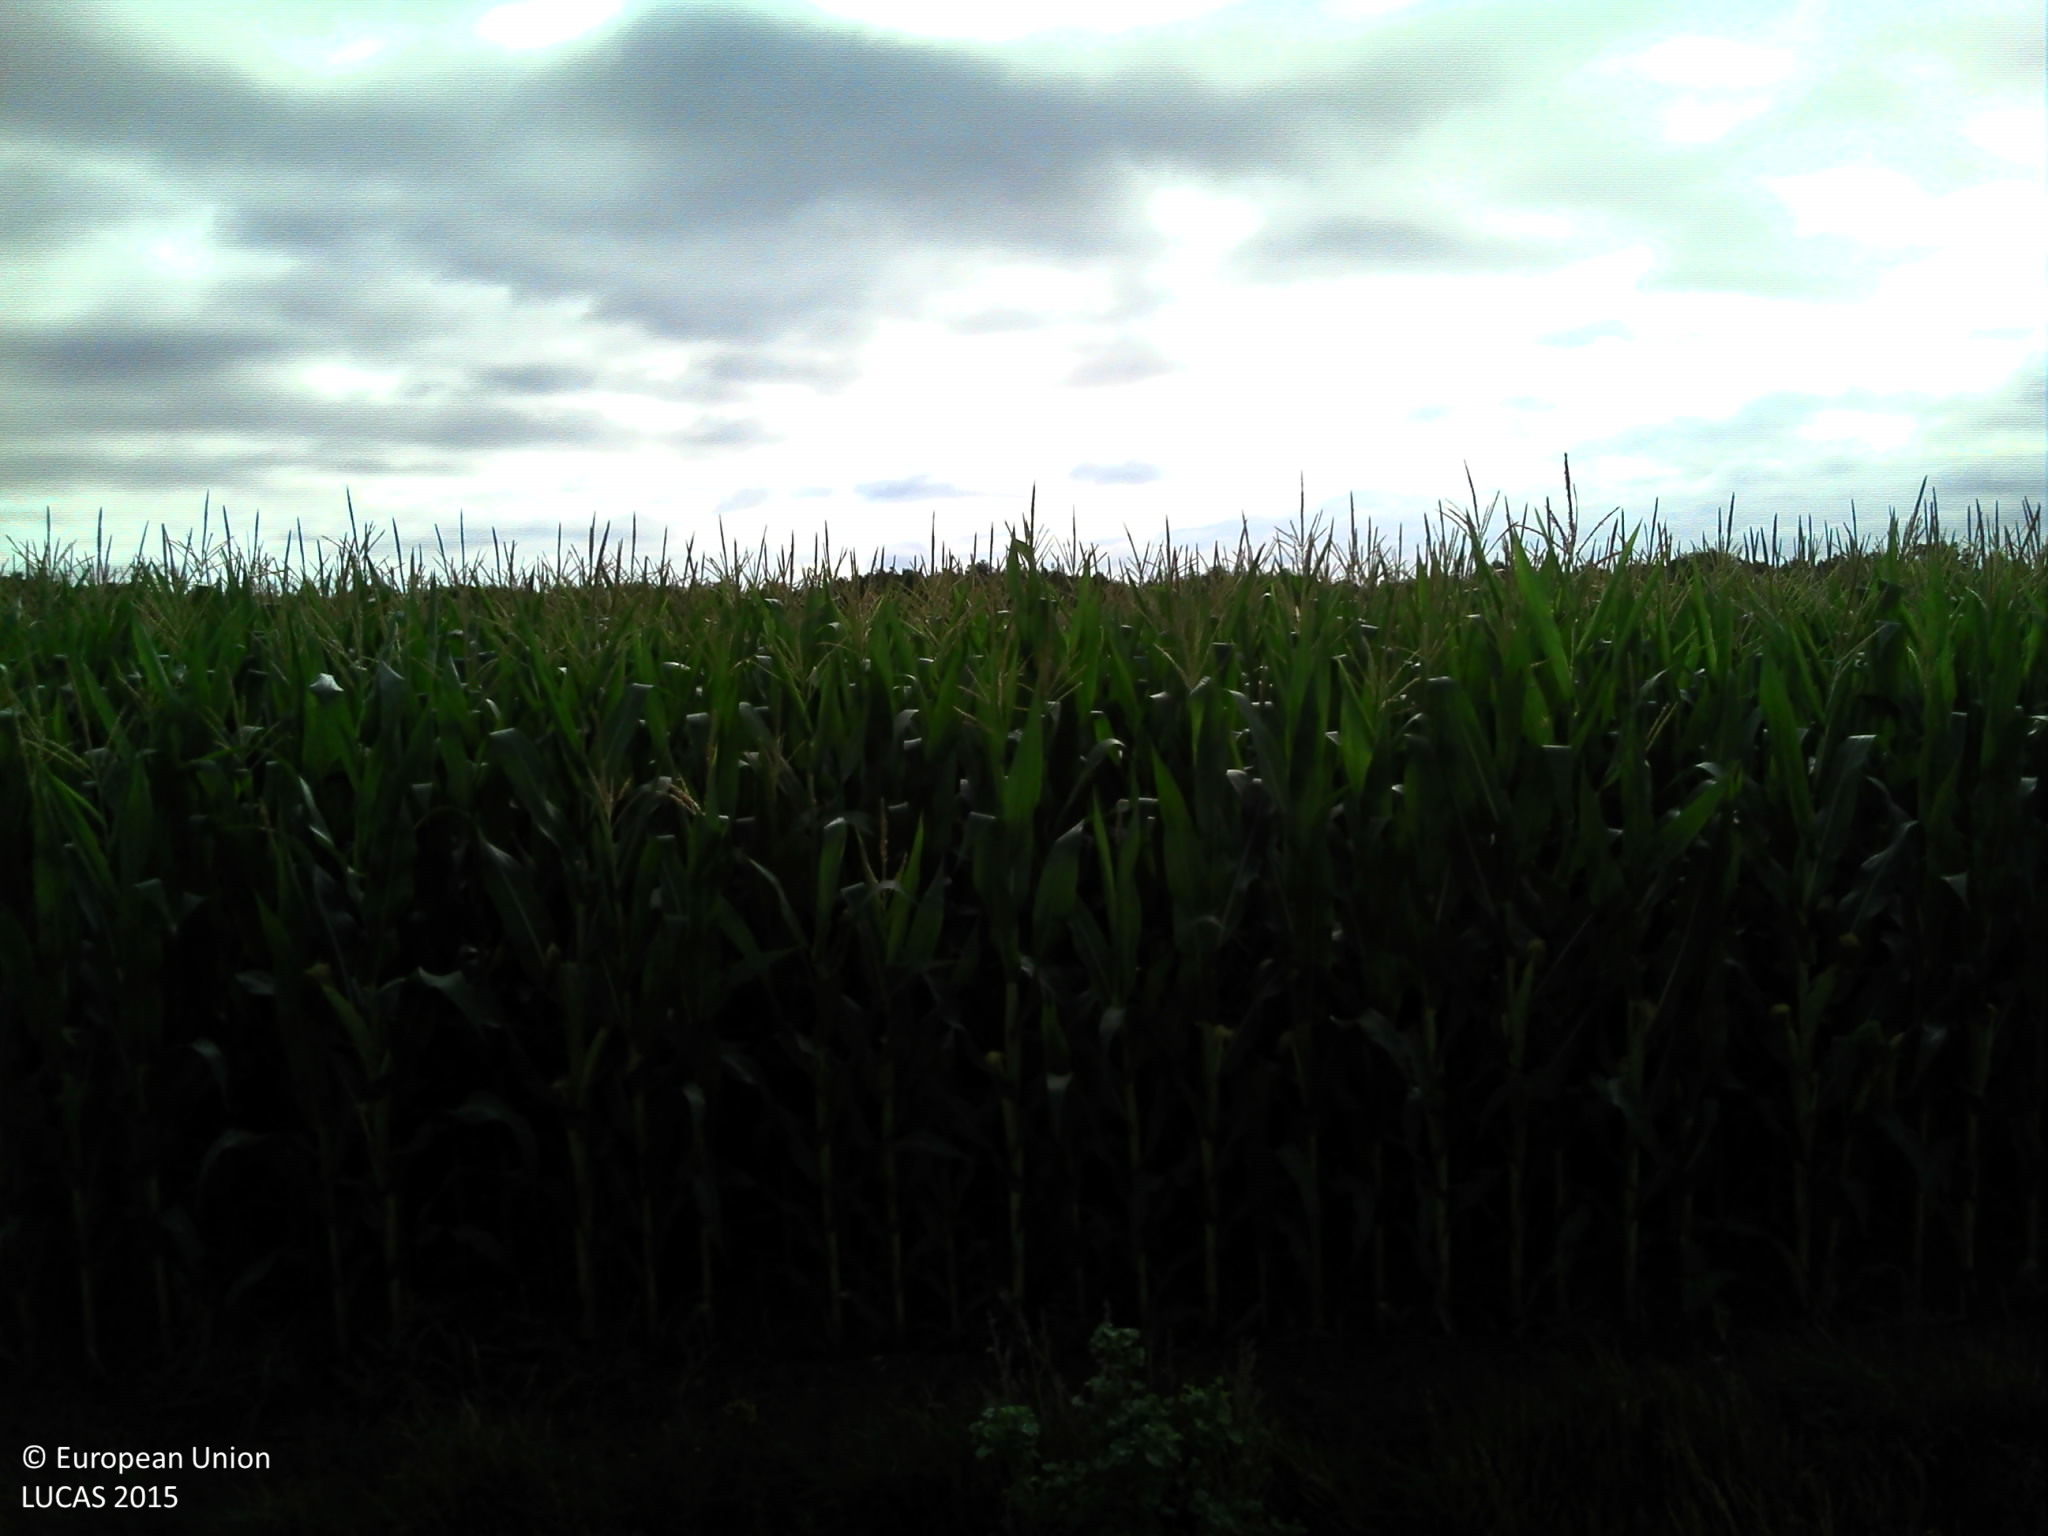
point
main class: Cropland
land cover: Maize
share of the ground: > 75 %
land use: Agriculture (excluding fallow land and kitchen gardens)
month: July
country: FR
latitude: 46.2988
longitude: 0.5979
